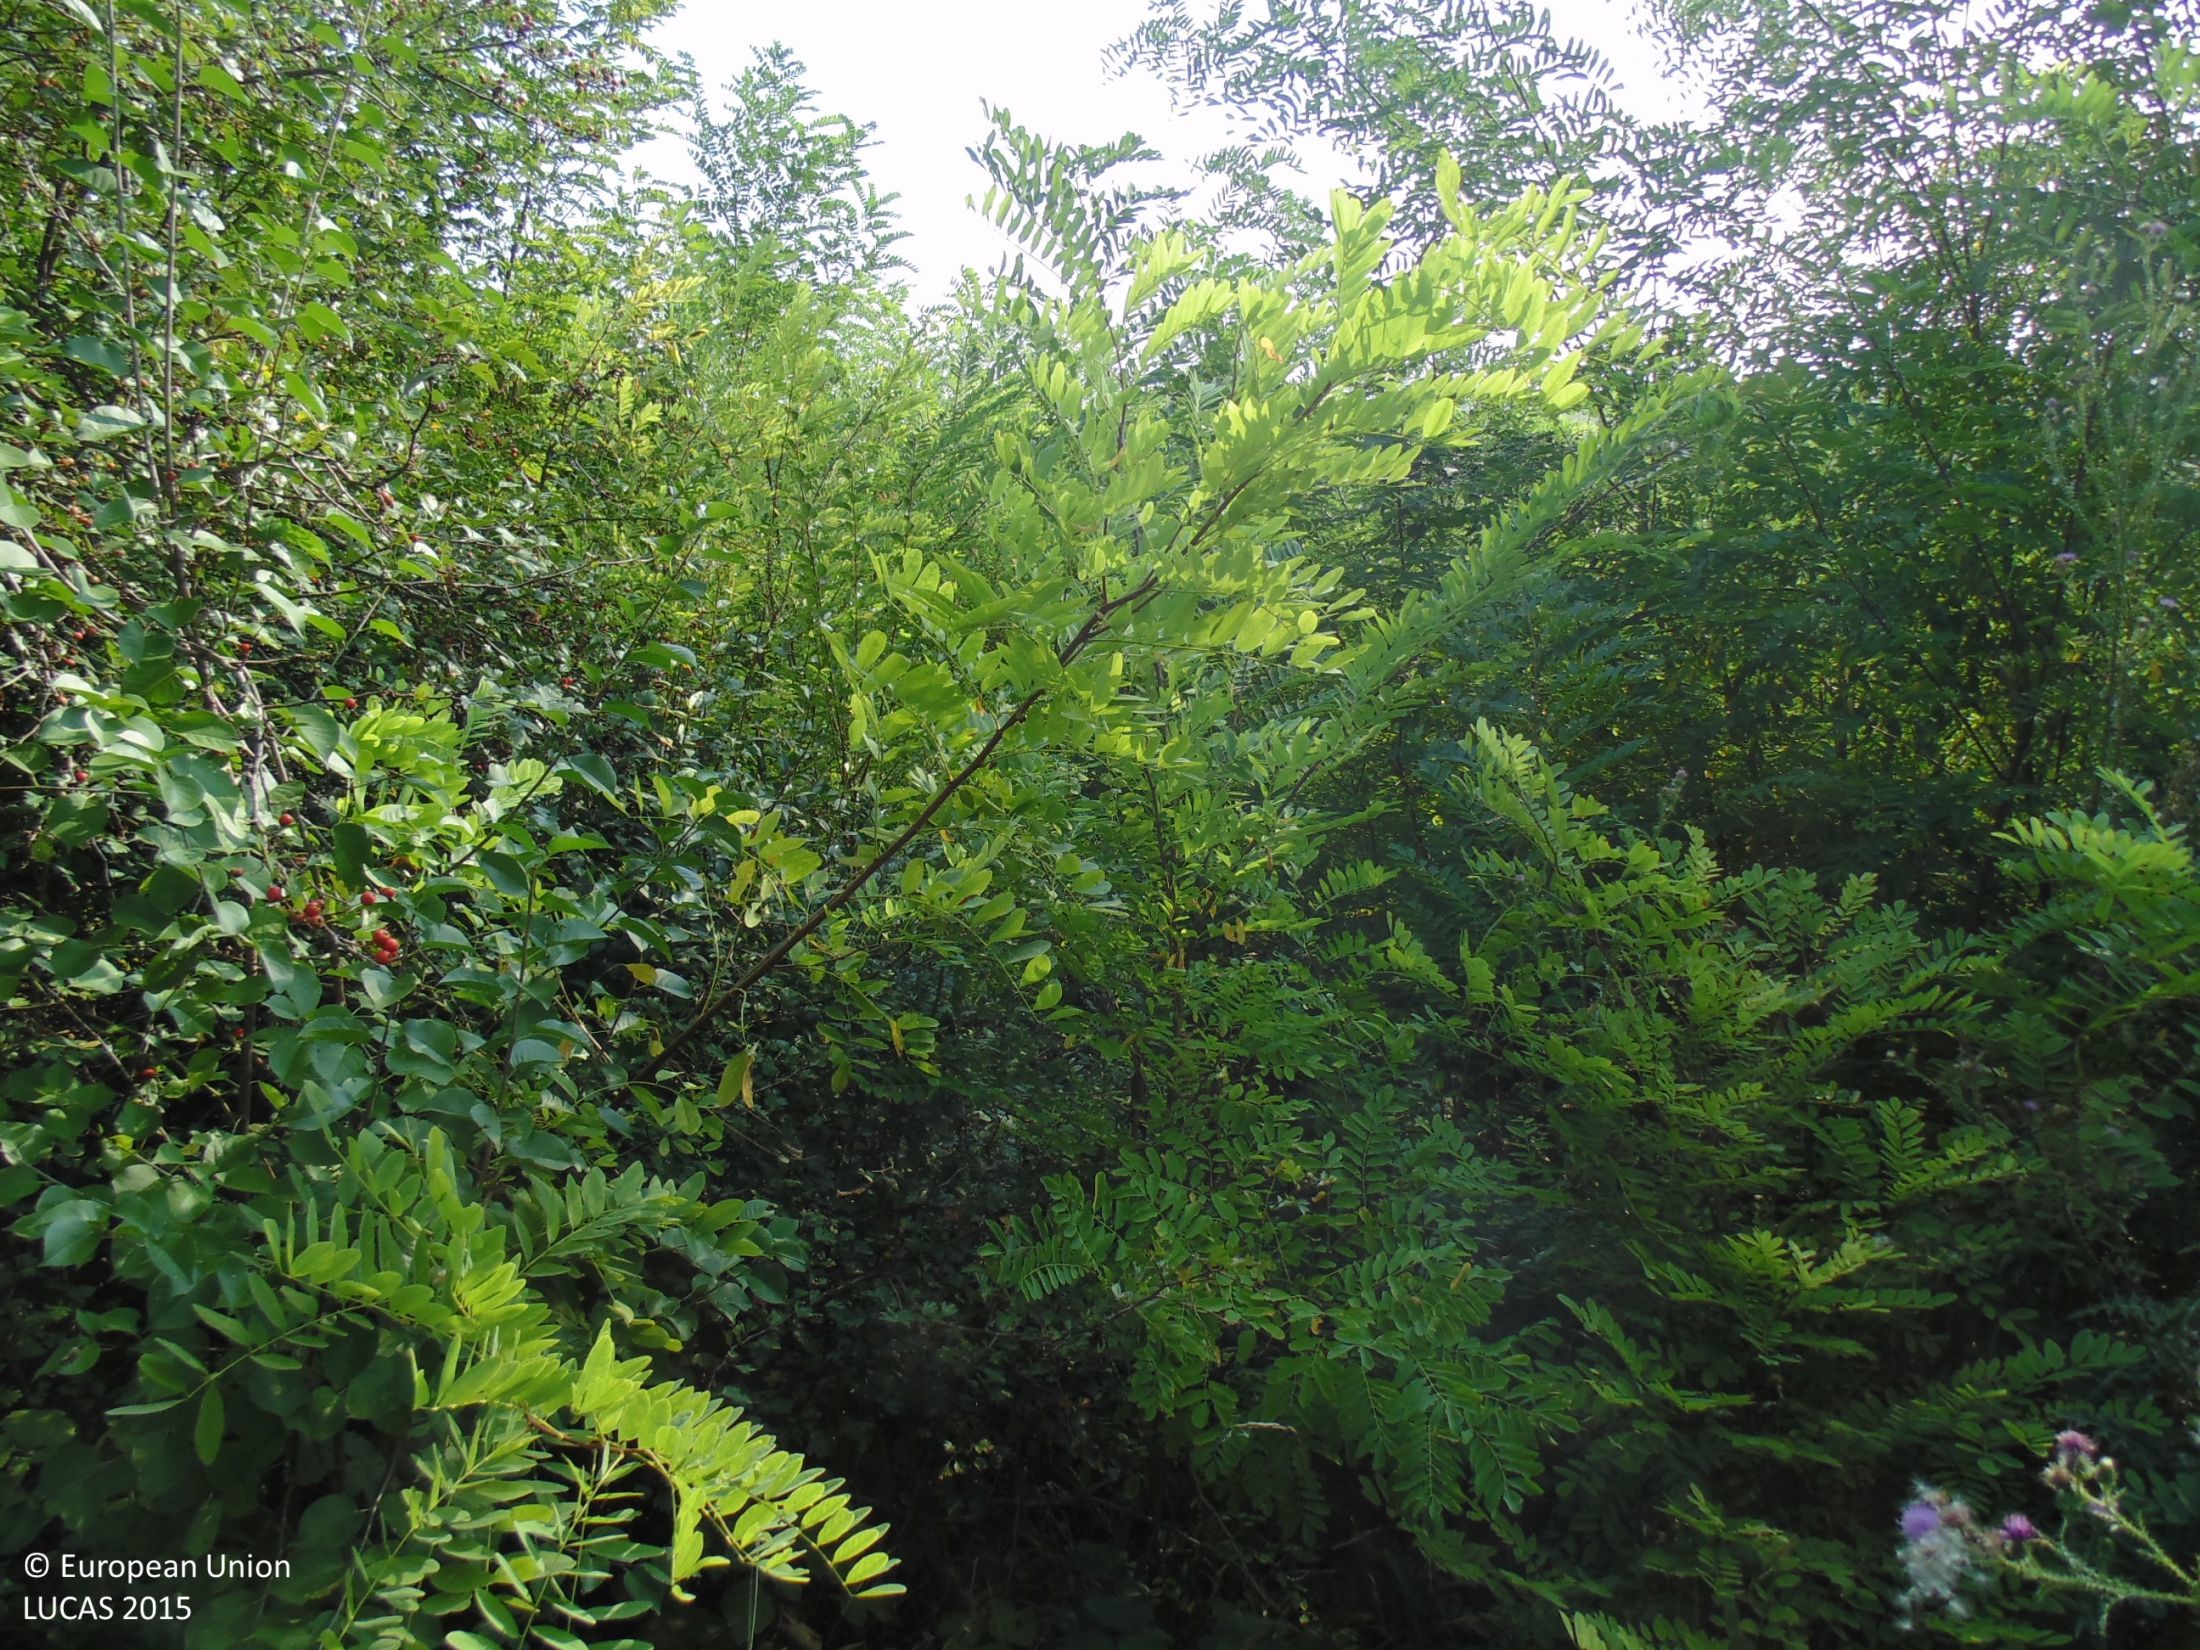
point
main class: Woodland
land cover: Broadleaved woodland
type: mesophytic deciduous forest
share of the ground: > 75 %
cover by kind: broadleaved forest trees 85 %, unconsolidated bare surface 10 %, shrubs 5 %
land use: Forestry
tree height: > 5 m
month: August
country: BG
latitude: 44.0112
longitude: 27.3845
